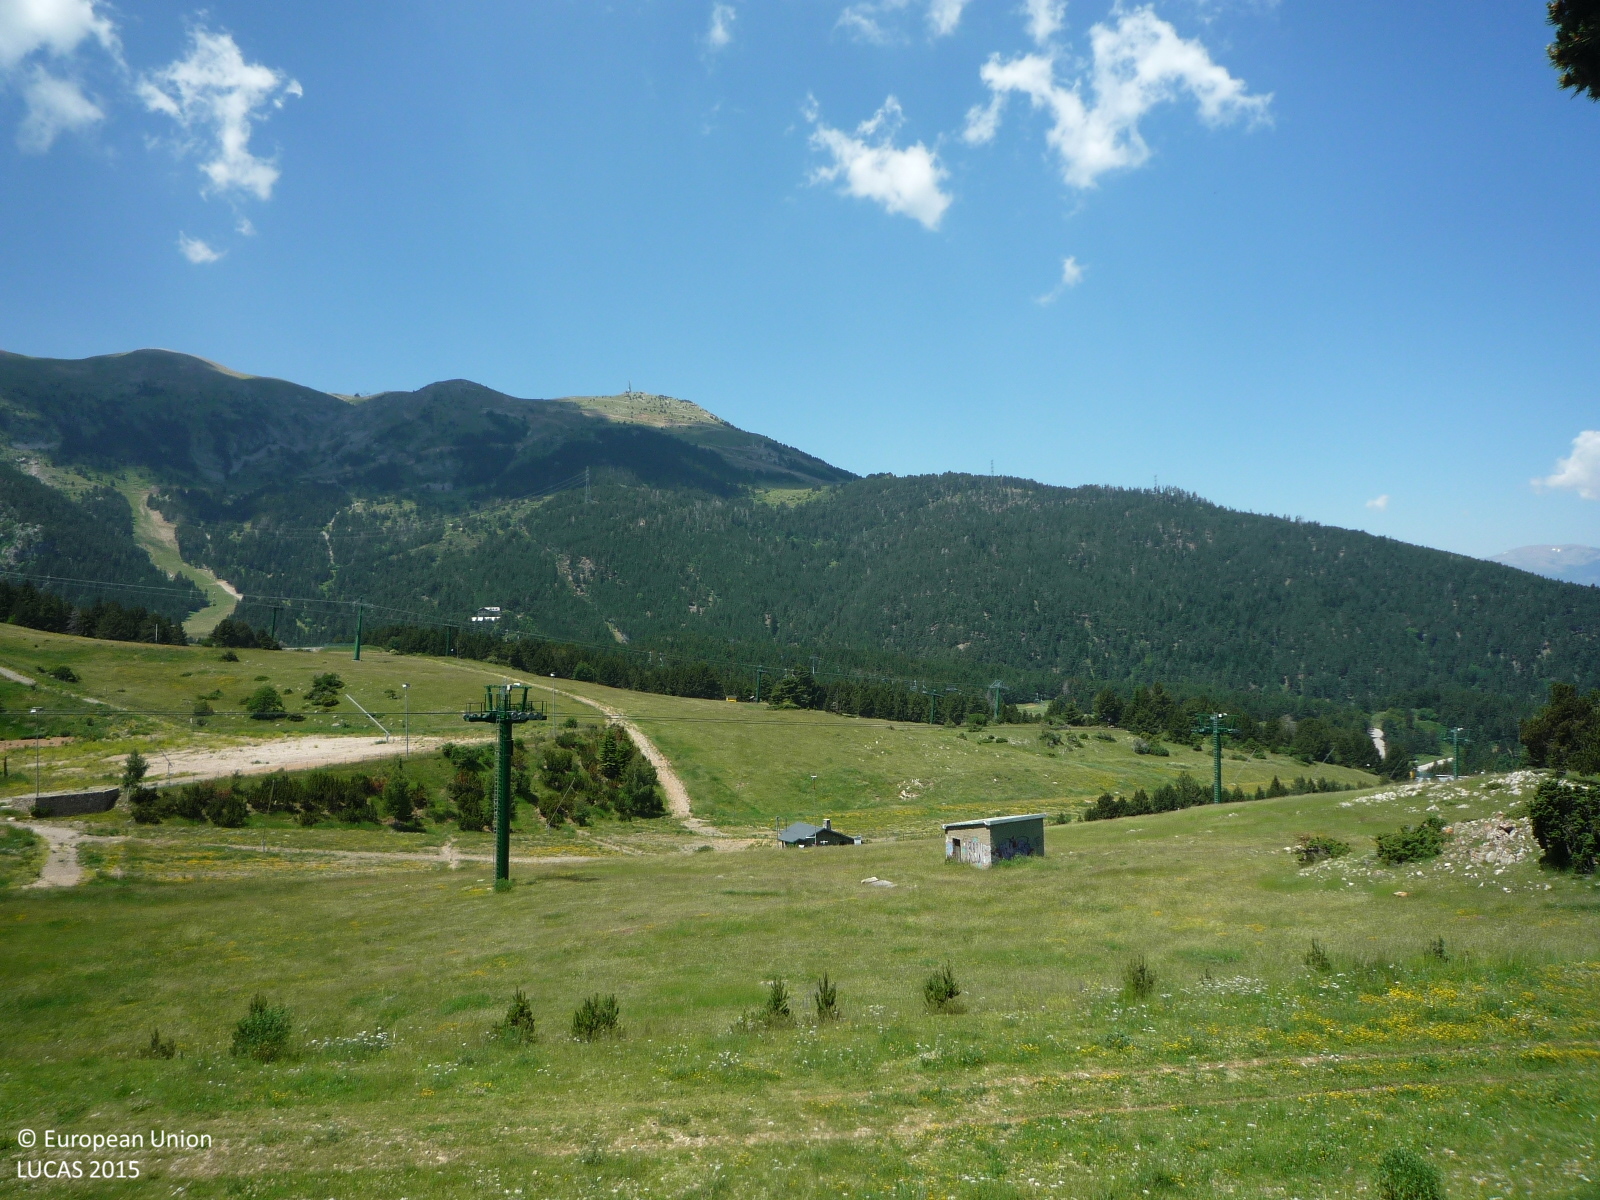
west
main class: Woodland
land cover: Pine dominated coniferous woodland
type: alpine coniferous forest
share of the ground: > 75 %
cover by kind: coniferous forest trees 80 %, shrubs 10 %, herbaceous plants 10 %
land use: Sport
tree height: > 5 m
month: June
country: ES
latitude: 42.3325
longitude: 1.9412
